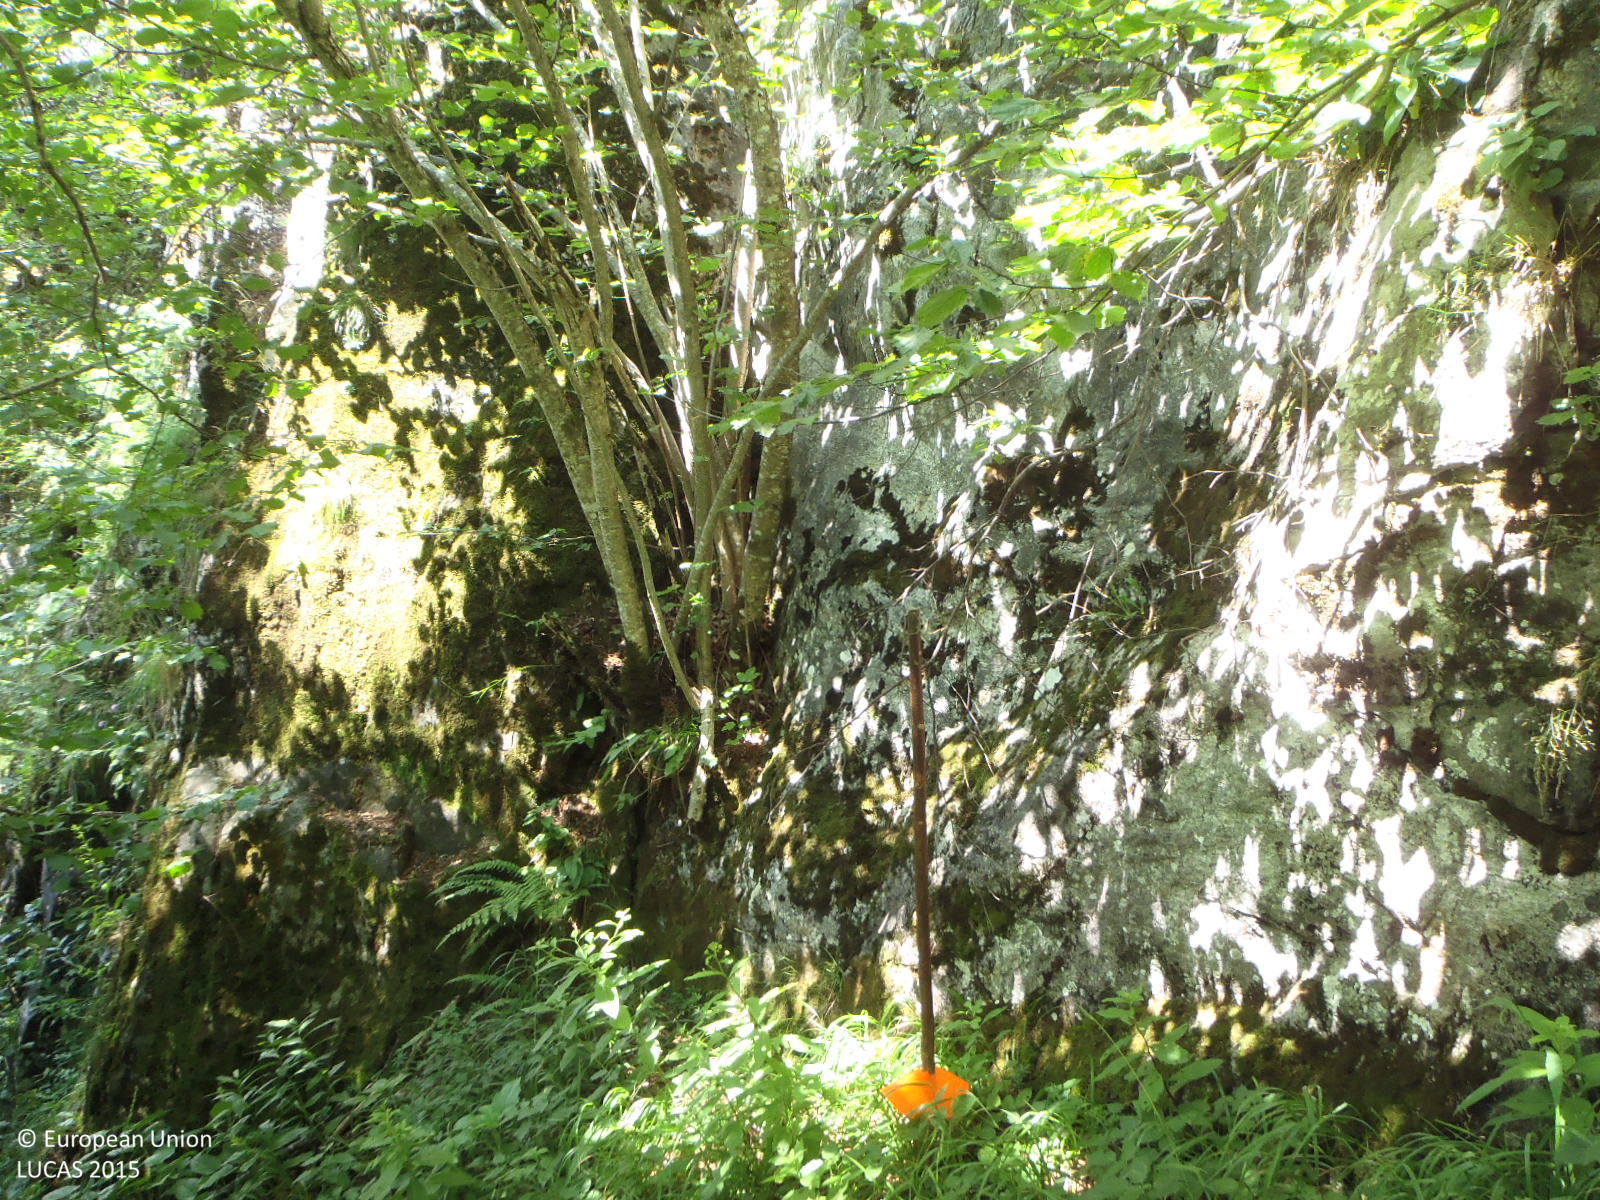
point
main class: Woodland
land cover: Broadleaved woodland
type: mountainous beech forest
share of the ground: > 75 %
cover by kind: broadleaved forest trees 75 %, coniferous forest trees 15 %, herbaceous plants 5 %, consolidated bare surface 5 %
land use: Forestry
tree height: > 5 m
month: July
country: AT
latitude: 47.0930
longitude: 11.7768
